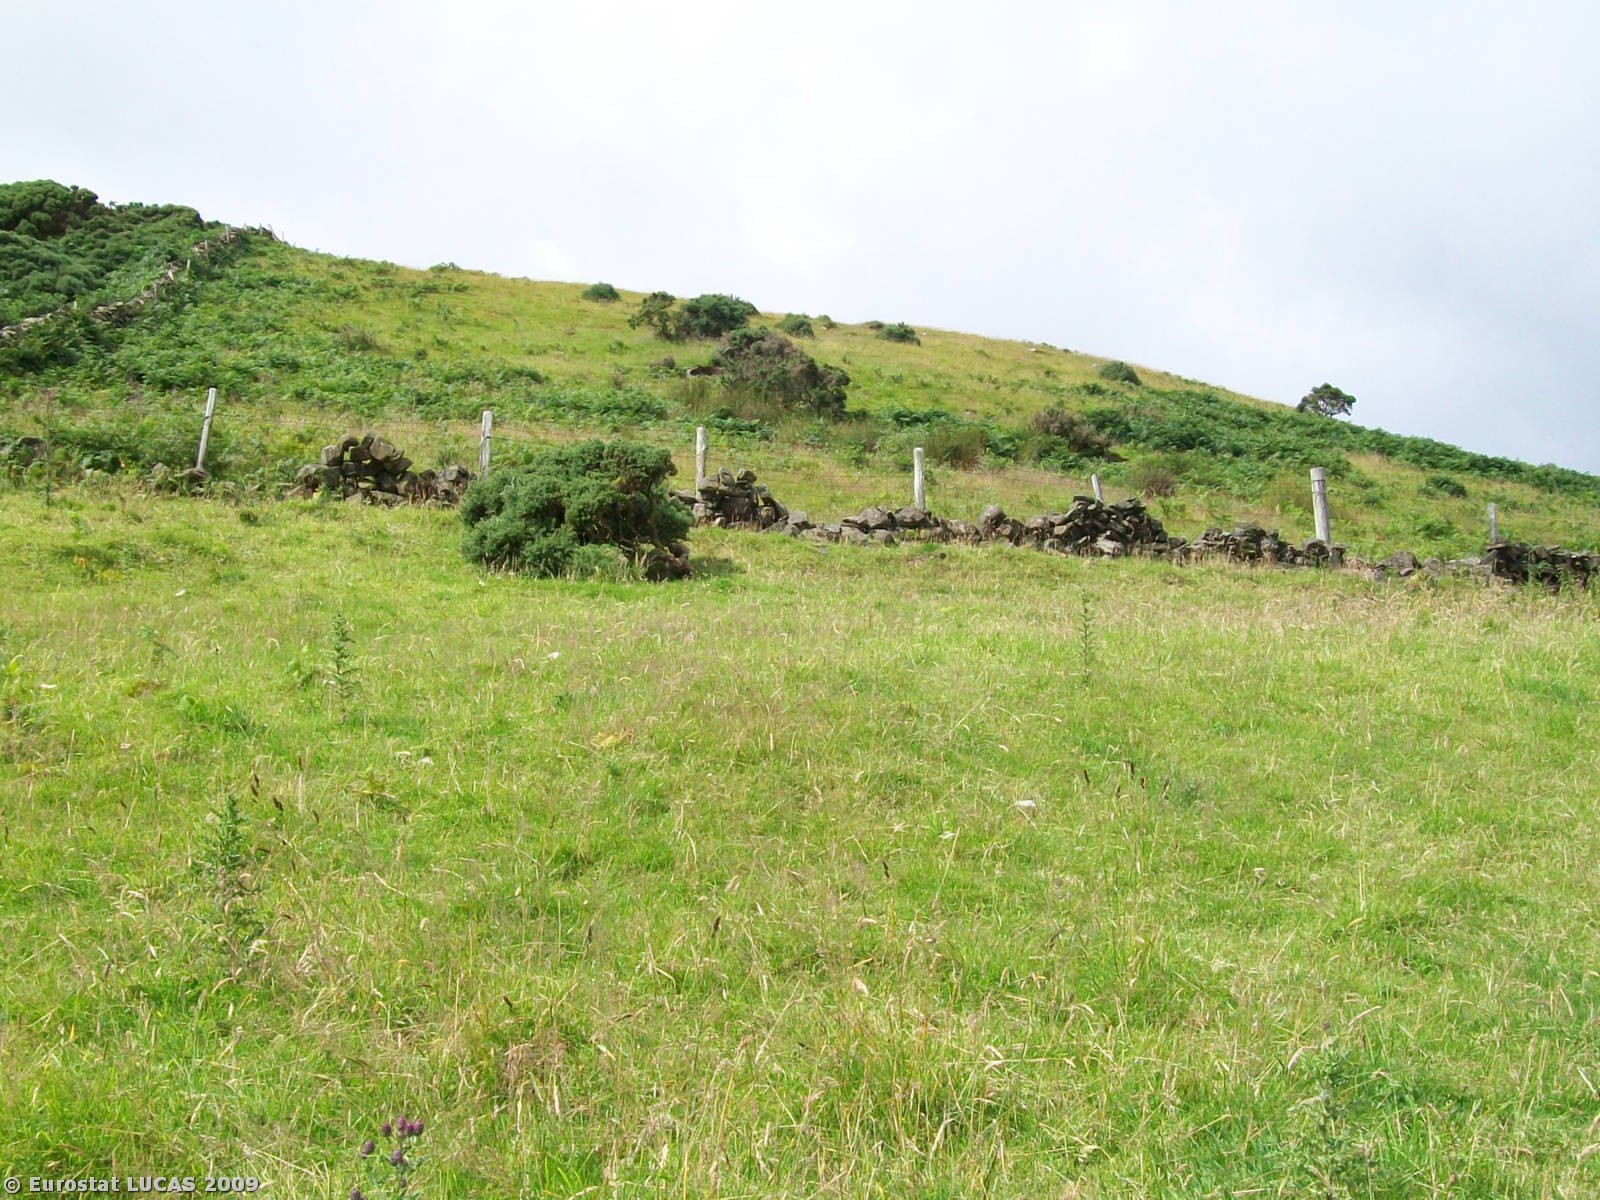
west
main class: Grassland
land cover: Grassland without tree/shrub cover
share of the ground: > 75 %
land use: Agriculture (excluding fallow land and kitchen gardens)
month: July
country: GB
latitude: 54.8929
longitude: -5.9000
